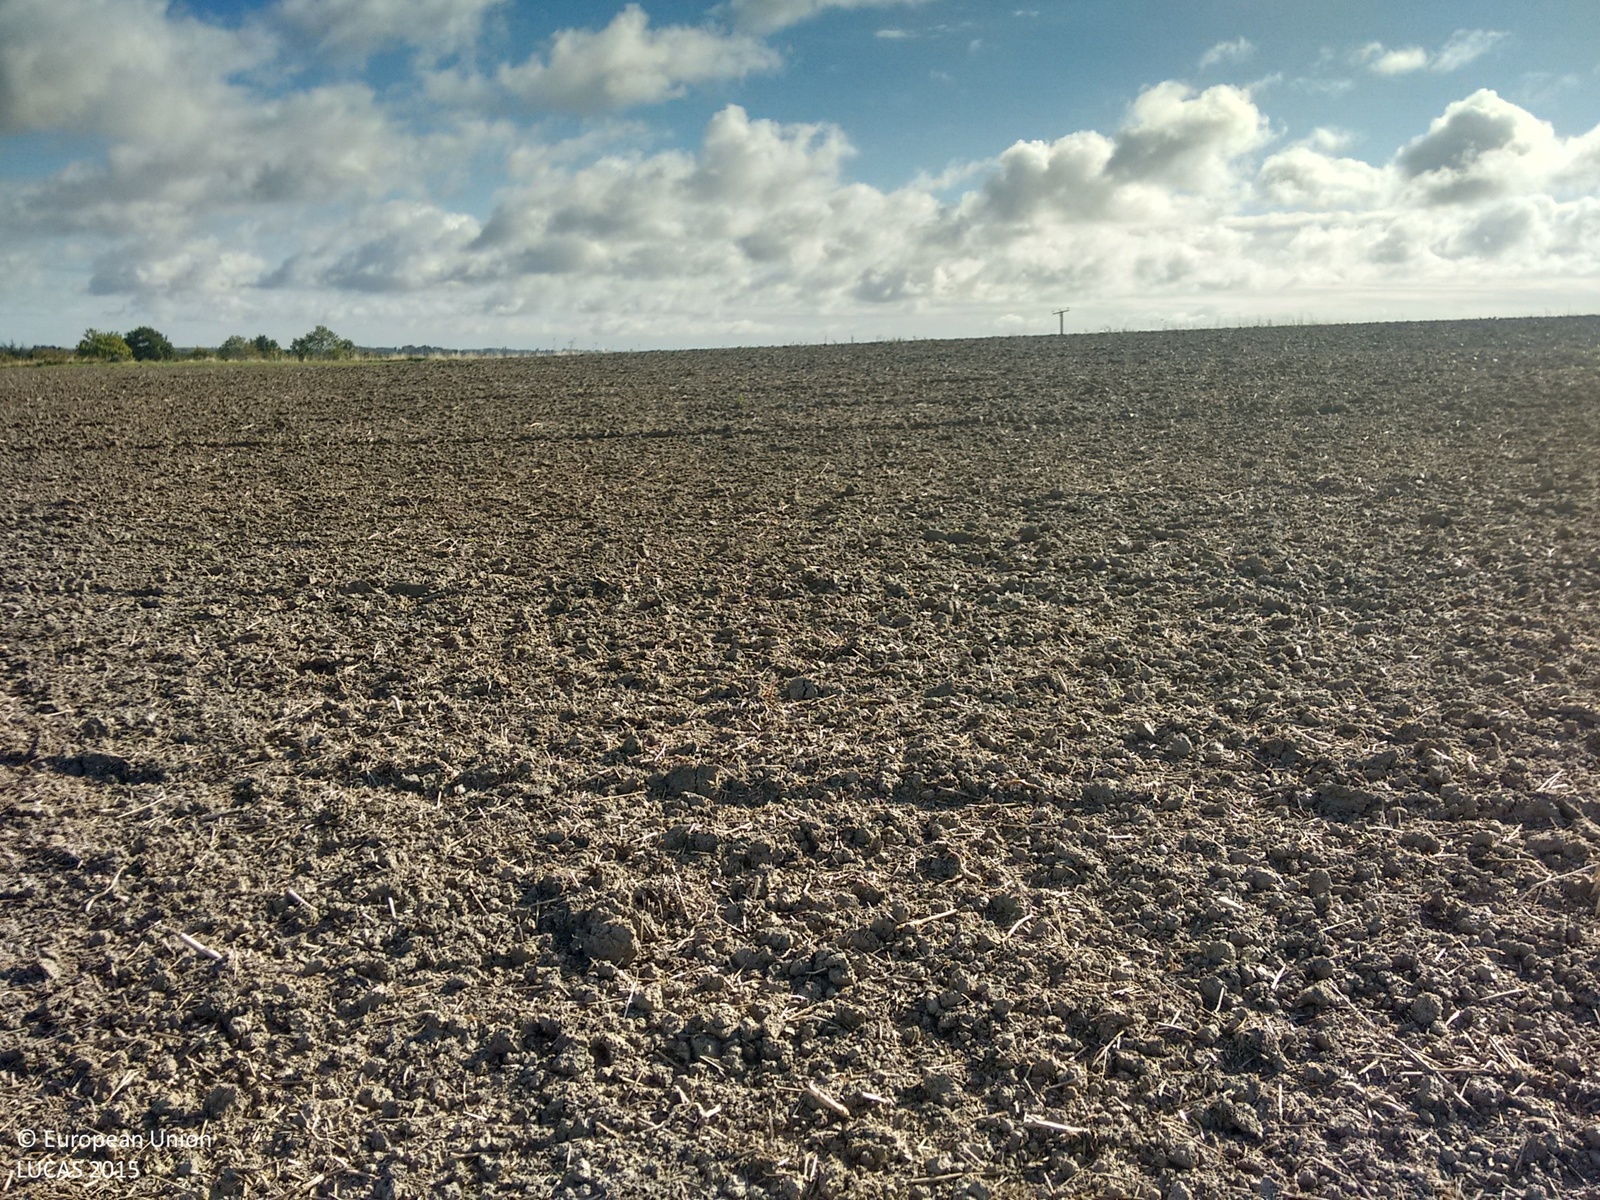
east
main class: Cropland
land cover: Rape and turnip rape
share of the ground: < 10 %
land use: Agriculture (excluding fallow land and kitchen gardens)
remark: Harvested field
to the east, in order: Rape and turnip rape; Grass margins; Tracks; Spontaneously vegetated surfaces; Rape and turnip rape; Electric lines; Rape and turnip rape
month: September
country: GB
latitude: 52.1700
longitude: -0.0193
